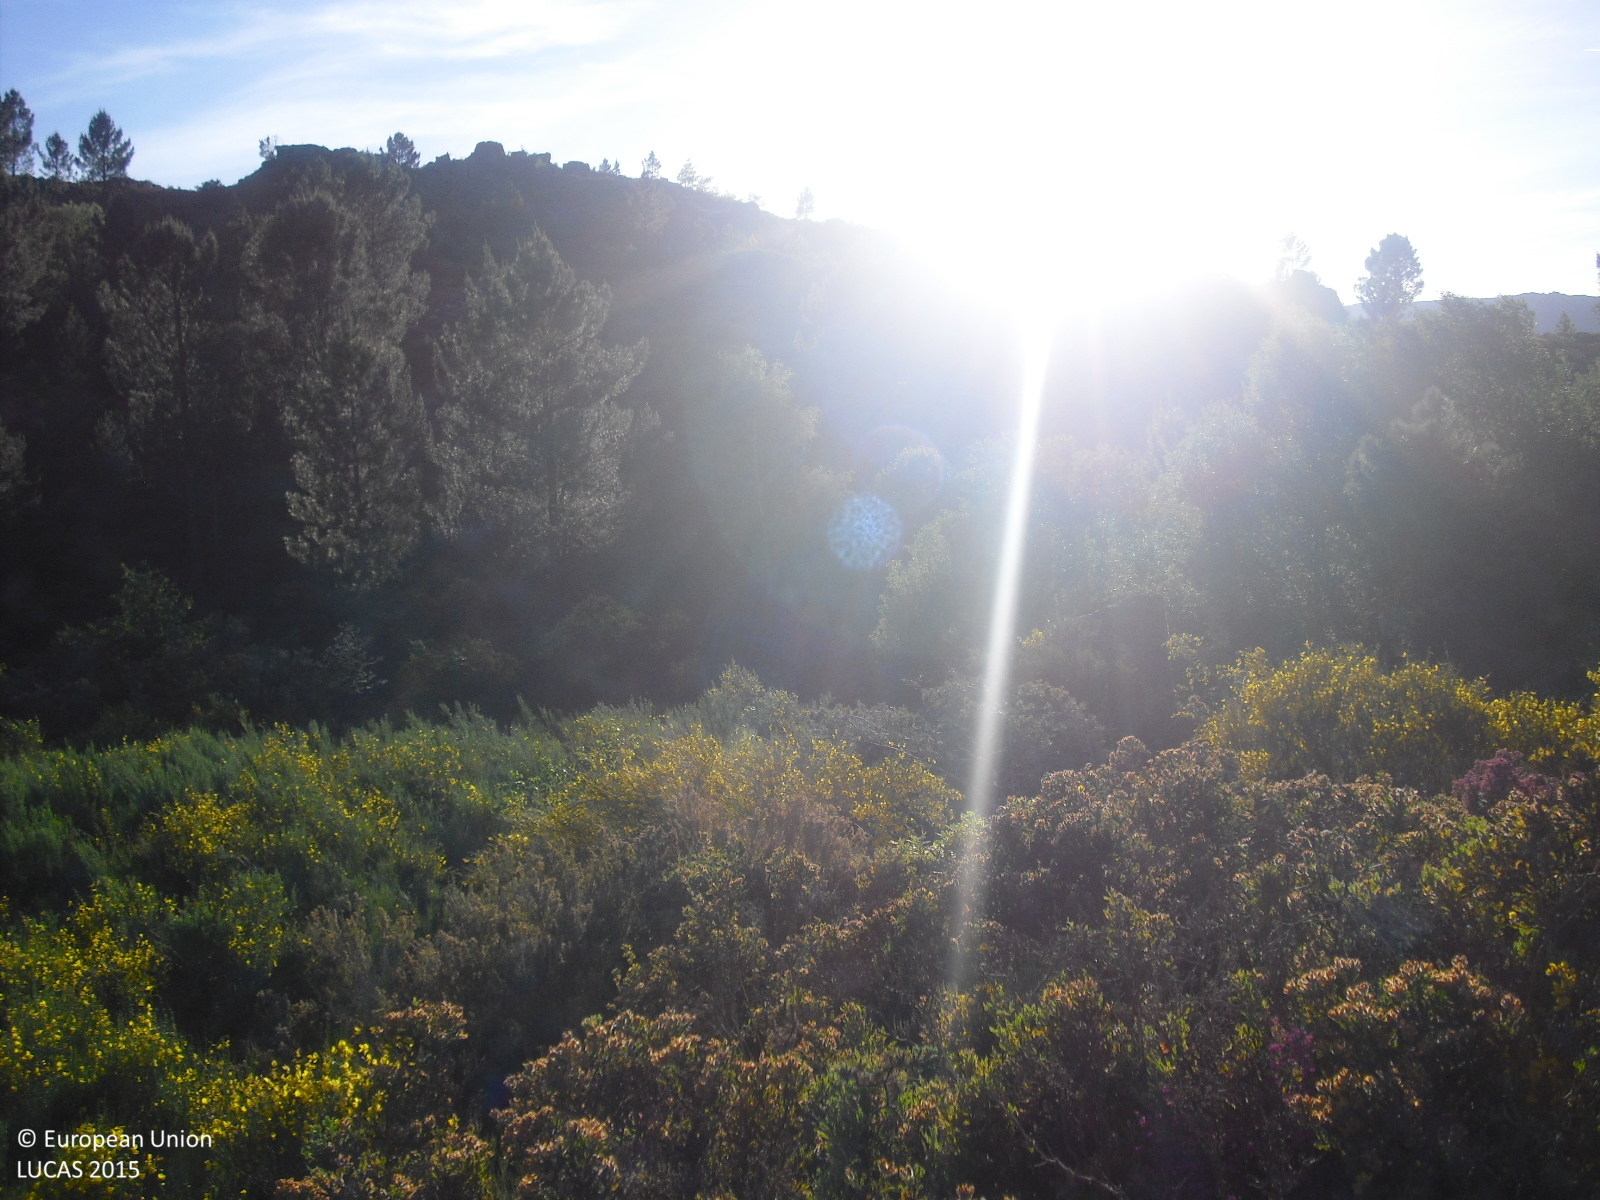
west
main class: Shrubland
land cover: Shrubland with sparse tree cover
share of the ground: > 75 %
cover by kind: shrubs 75 %, consolidated bare surface 20 %, coniferous forest trees 5 %
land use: Semi-natural and natural areas not in use
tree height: < 5 m
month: May
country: ES
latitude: 41.8373
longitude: -8.1040
